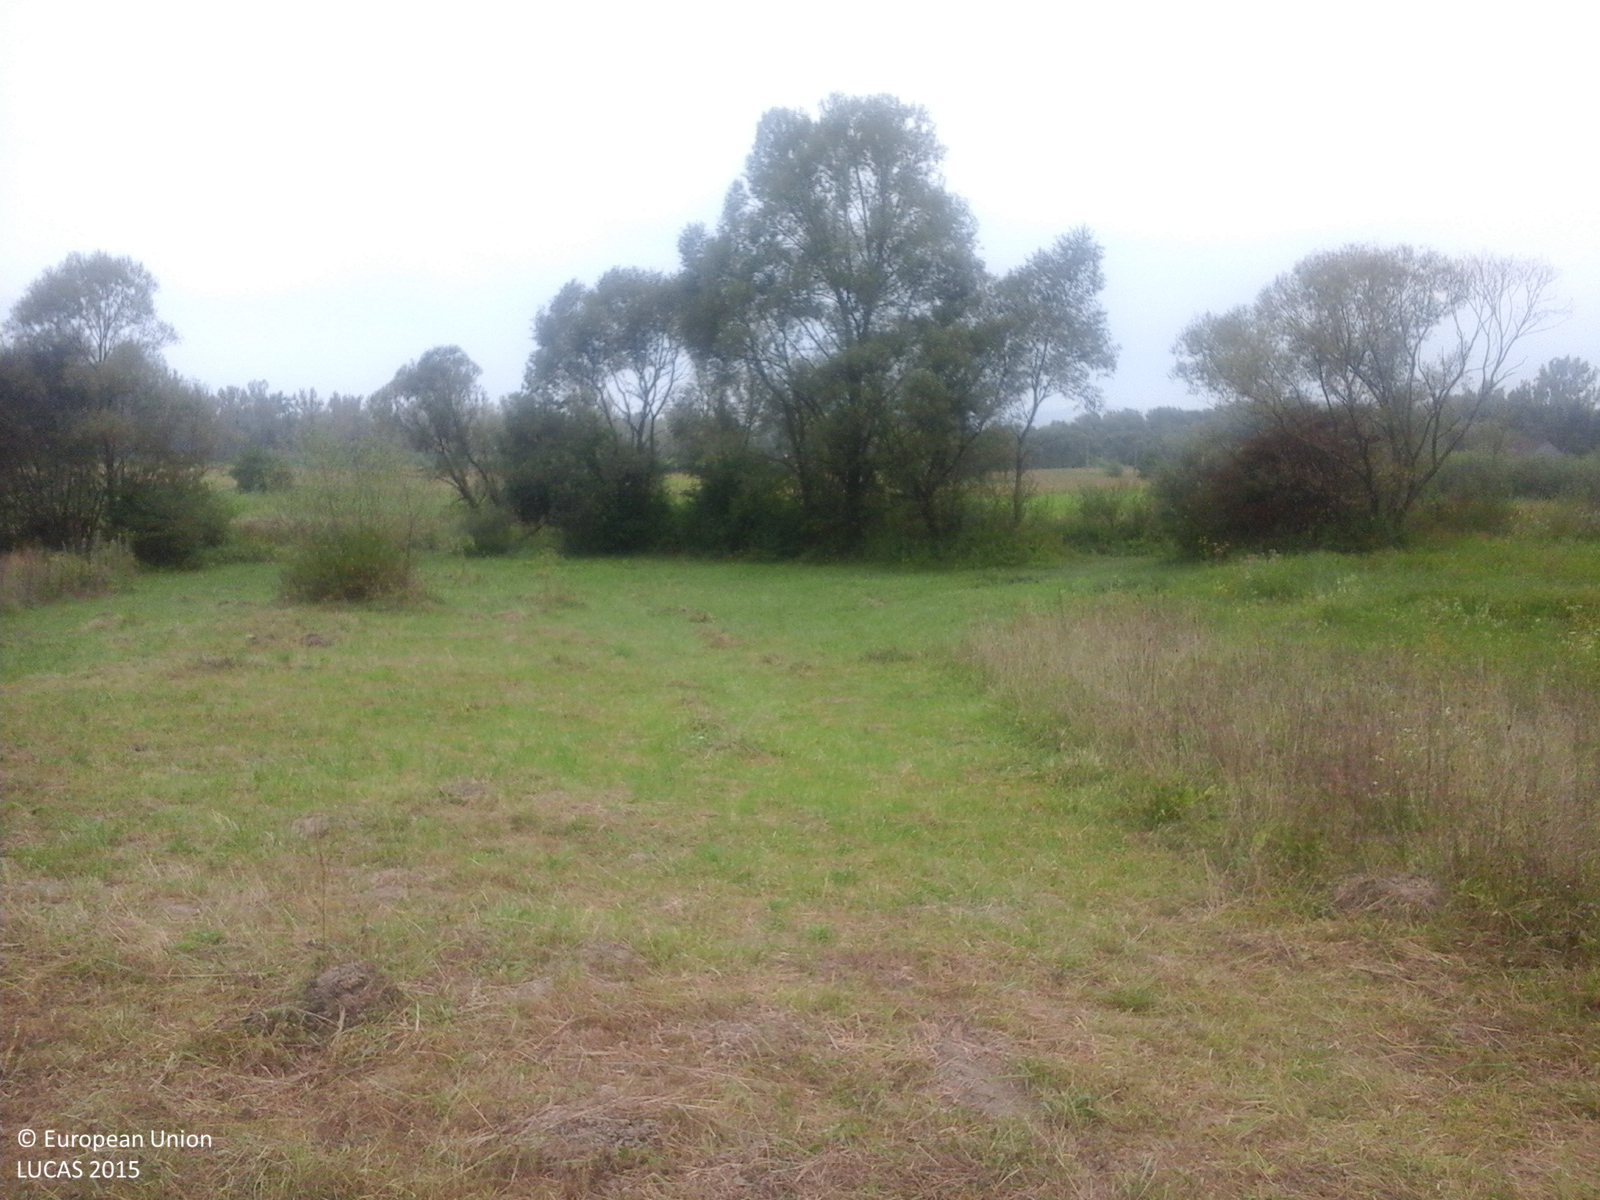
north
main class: Grassland
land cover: Grassland without tree/shrub cover
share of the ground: > 75 %
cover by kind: herbaceous plants 100 %
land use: Agriculture (excluding fallow land and kitchen gardens)
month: September
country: RO
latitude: 47.9994
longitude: 23.5742
